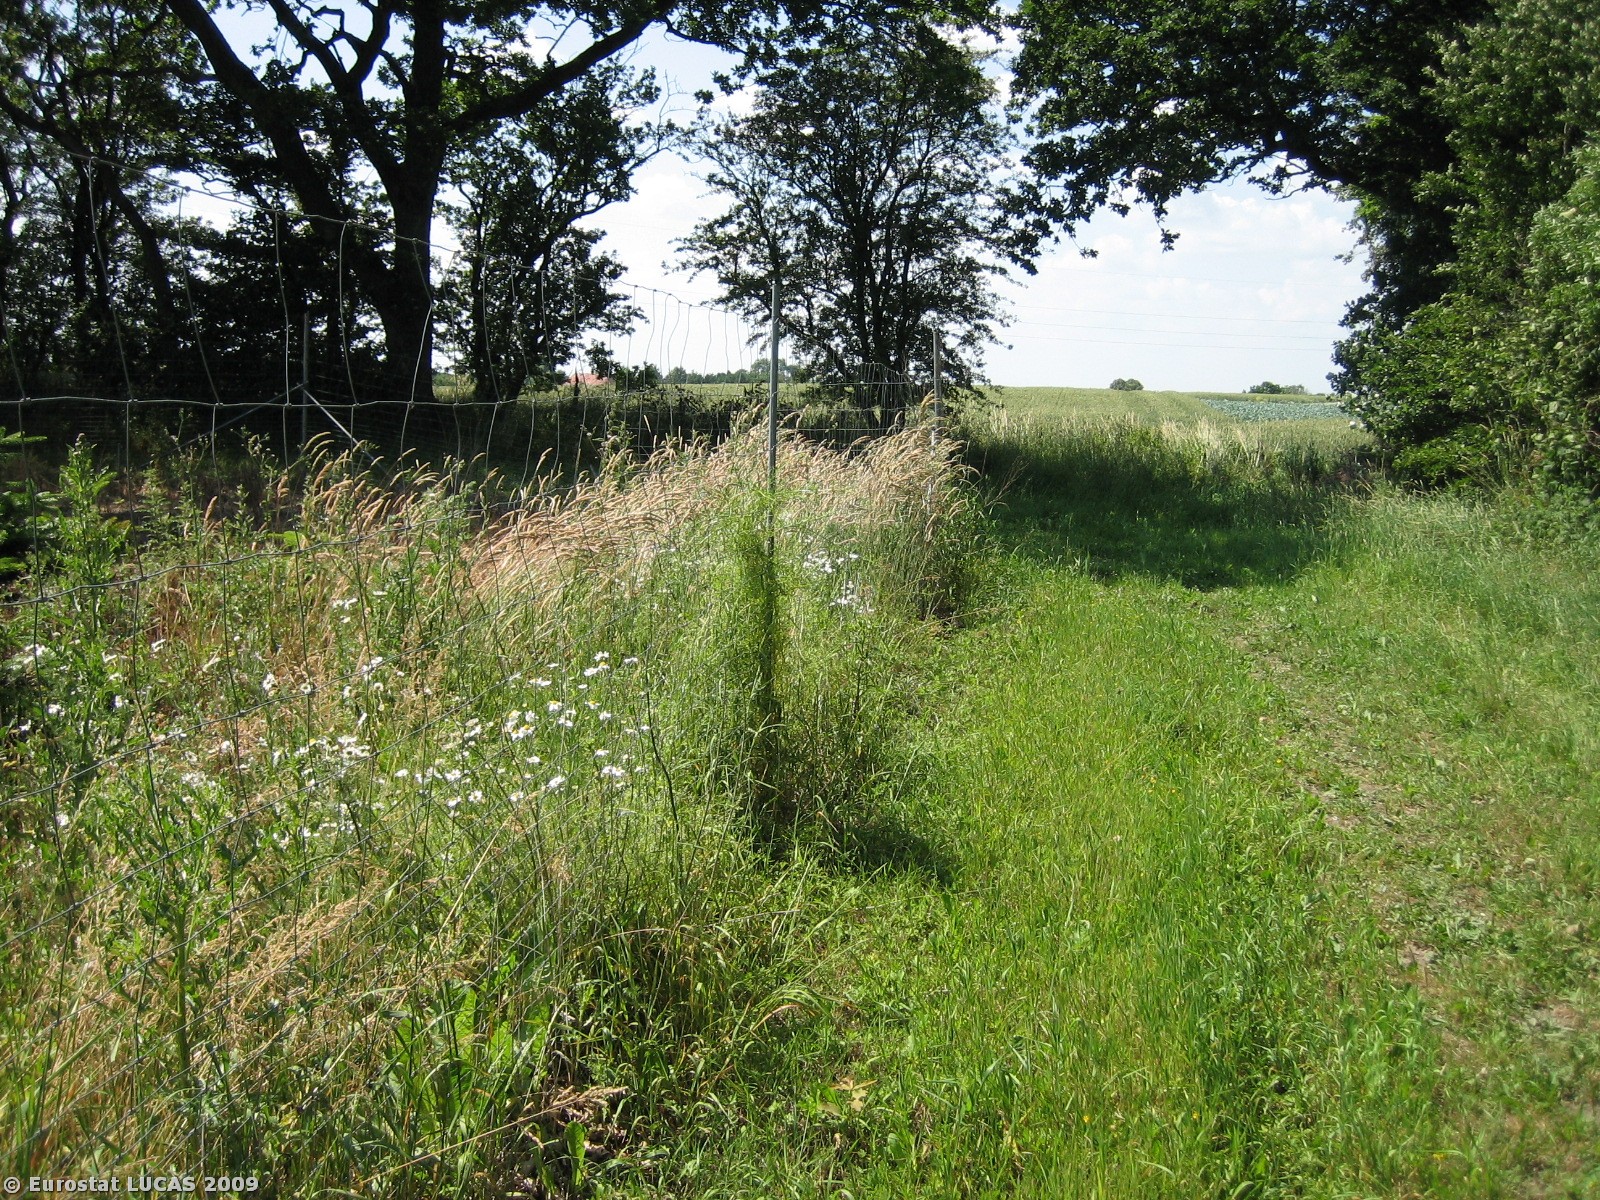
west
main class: Woodland
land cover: Coniferous woodland
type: hemiboreal forest and nemoral coniferous forest and mixed broadleaved-coniferous forest
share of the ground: 50 - 75 %
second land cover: Spontaneously vegetated surfaces
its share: 25 - 50 %
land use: Forestry
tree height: > 5 m
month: July
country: DK
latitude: 55.3589
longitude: 9.2908
